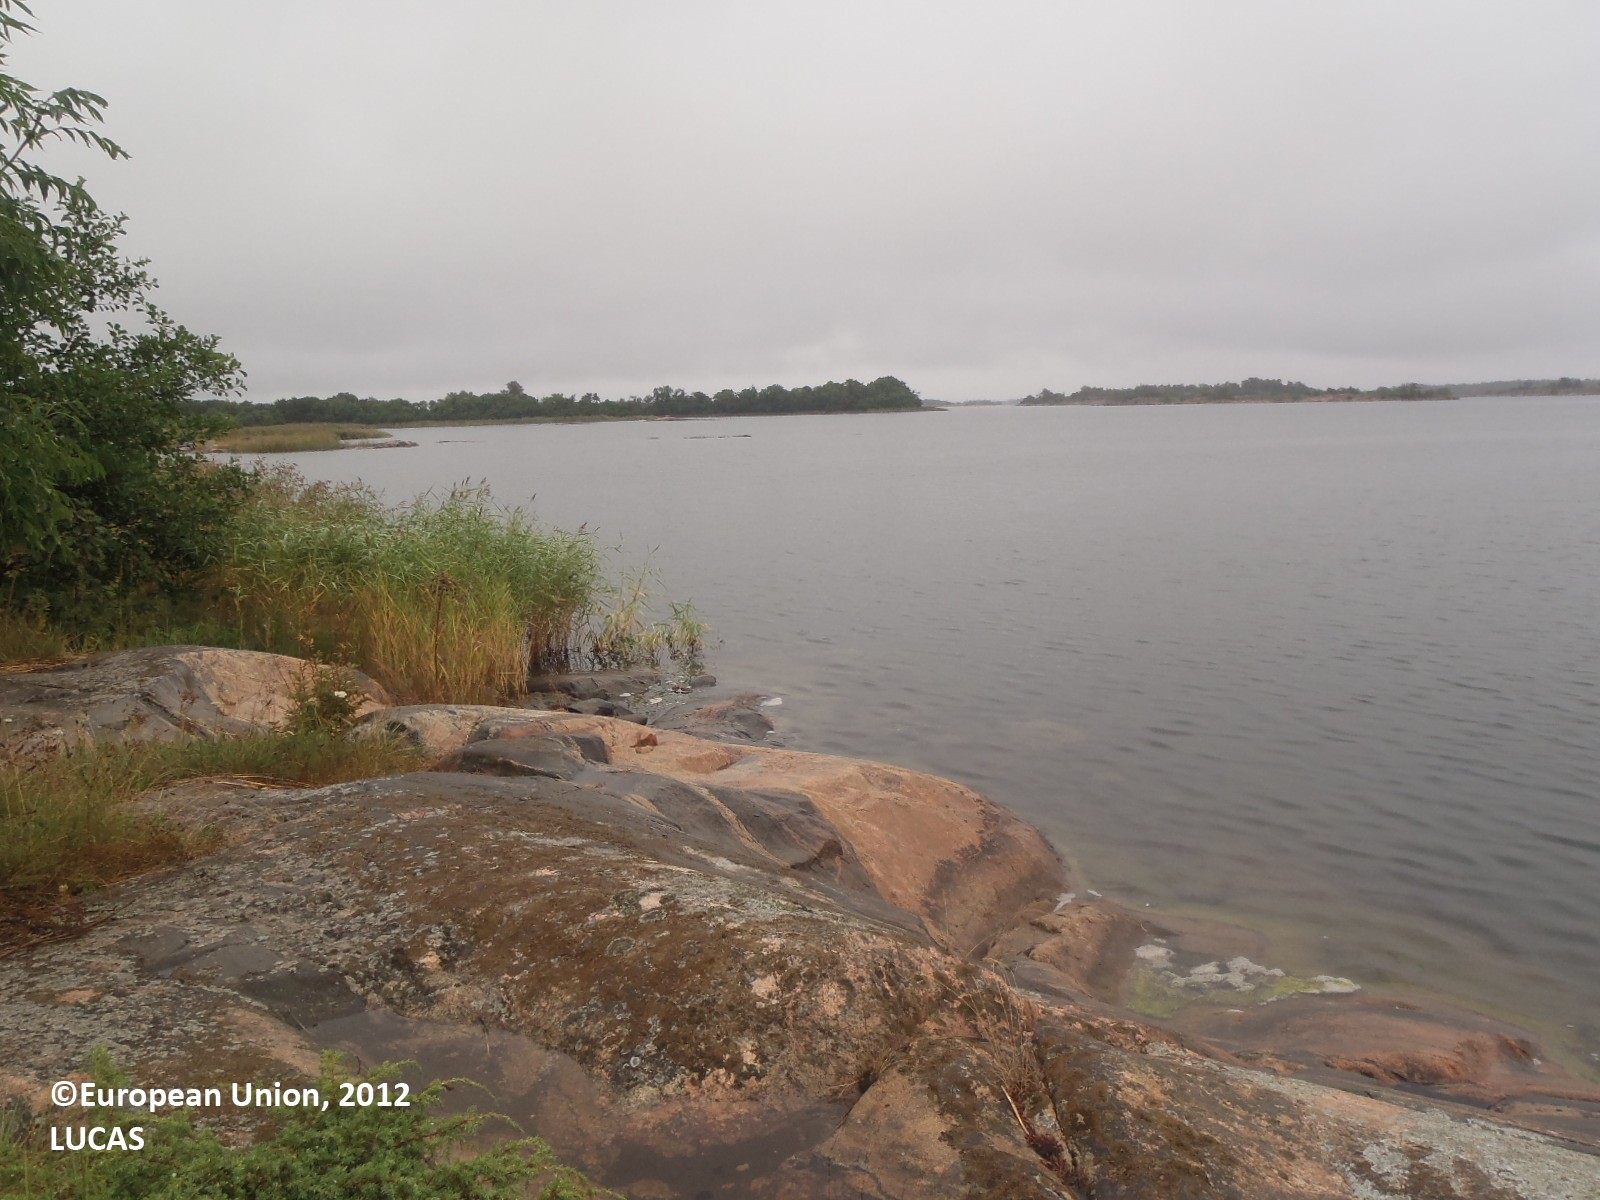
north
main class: Grassland
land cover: Grassland with sparse tree/shrub cover
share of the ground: > 75 %
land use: Semi-natural and natural areas not in use
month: August
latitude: 60.4252
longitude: 20.9674
